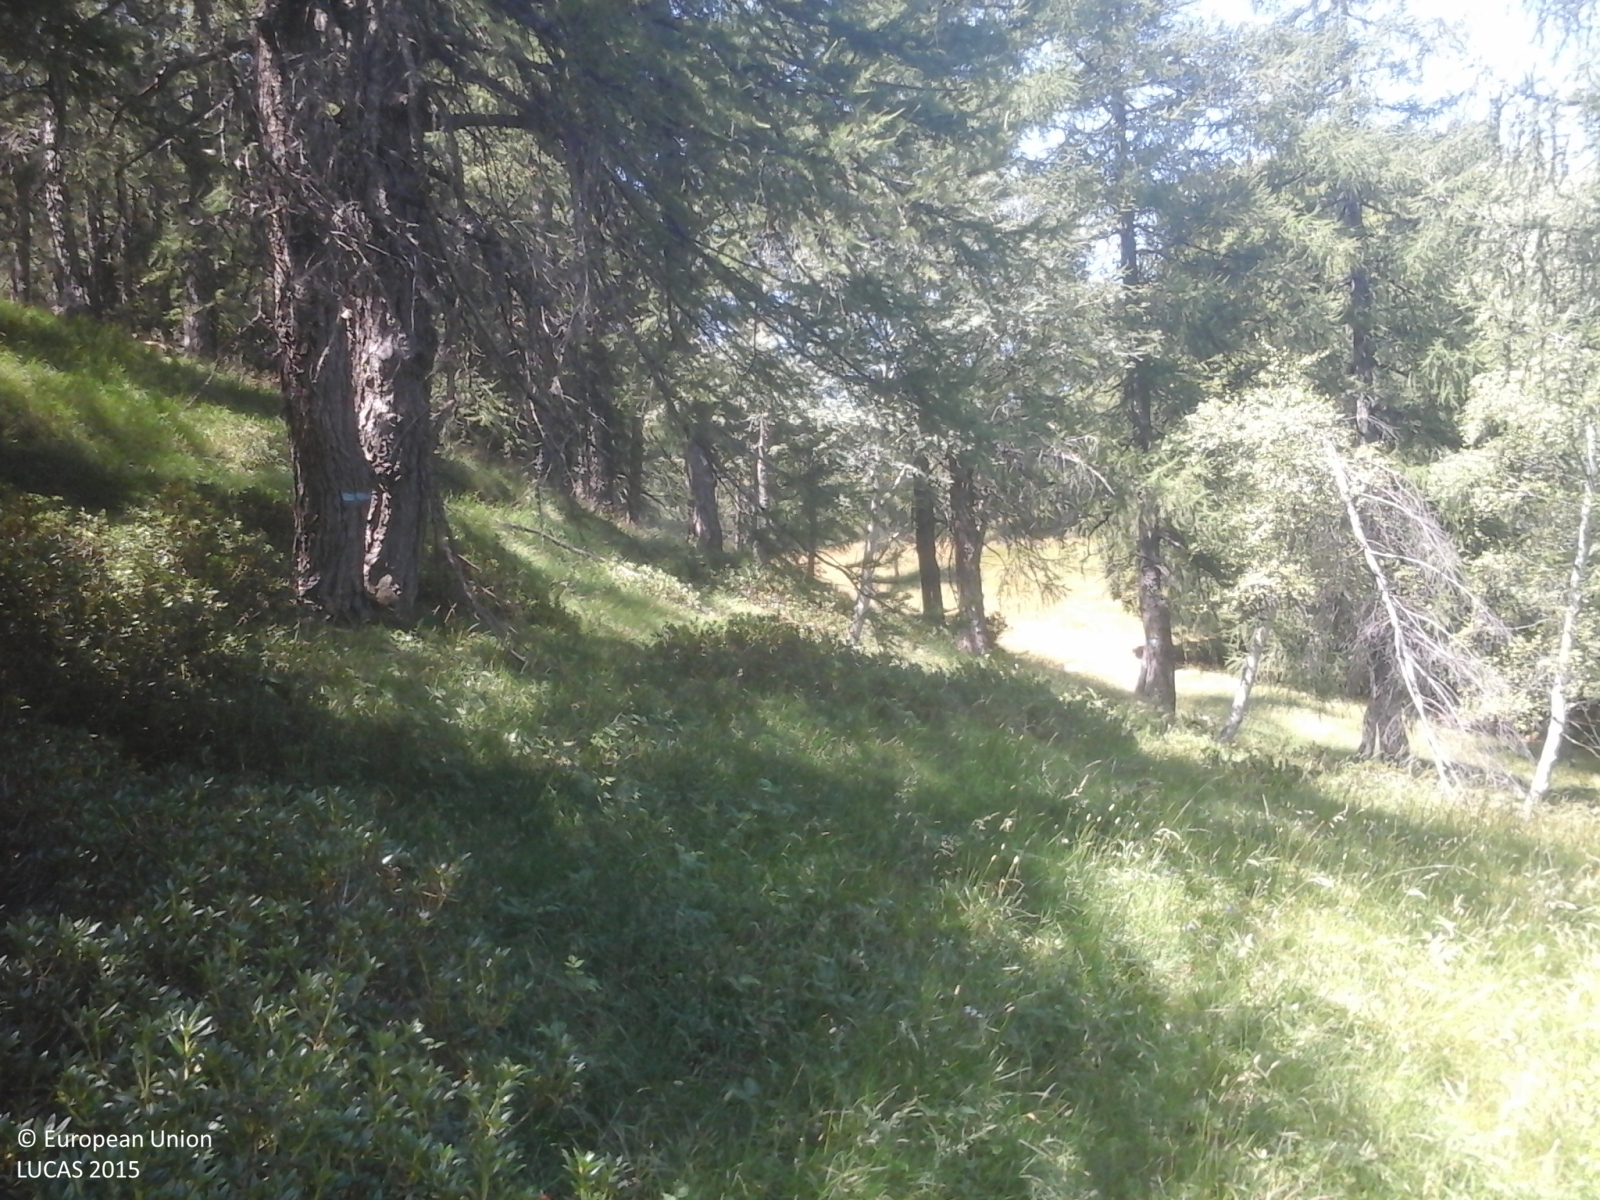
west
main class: Woodland
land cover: Spruce dominated mixed woodland
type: alpine coniferous forest
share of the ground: > 75 %
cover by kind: coniferous forest trees 65 %, broadleaved forest trees 25 %, herbaceous plants 10 %
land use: Forestry
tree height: > 5 m
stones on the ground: < 10 %
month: July
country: IT
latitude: 46.0971
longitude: 9.3671
